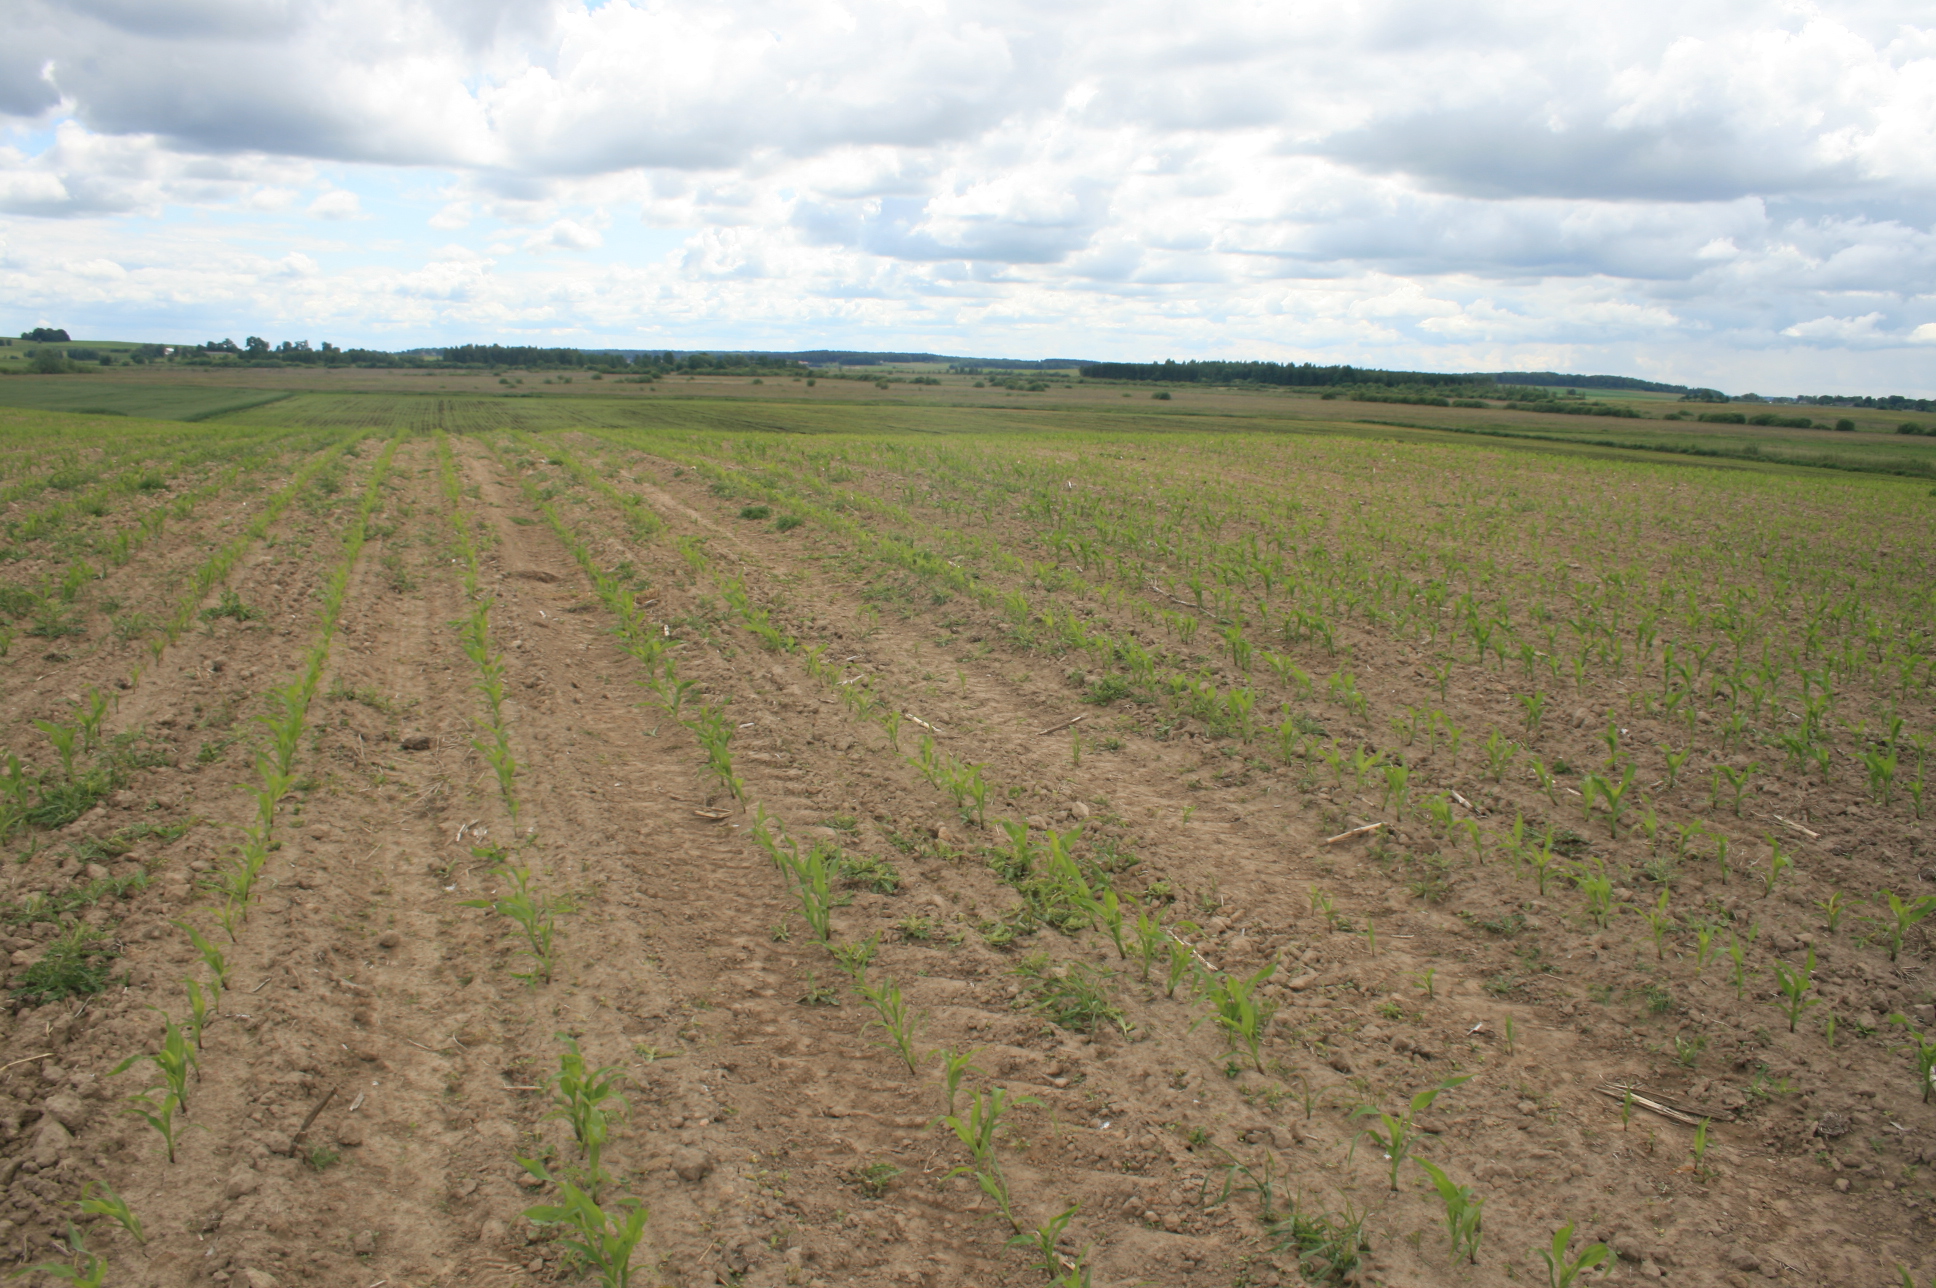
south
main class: Cropland
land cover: Maize
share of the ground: 25 - 50 %
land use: Agriculture (excluding fallow land and kitchen gardens)
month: June
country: LT
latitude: 55.1465
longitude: 22.0262
